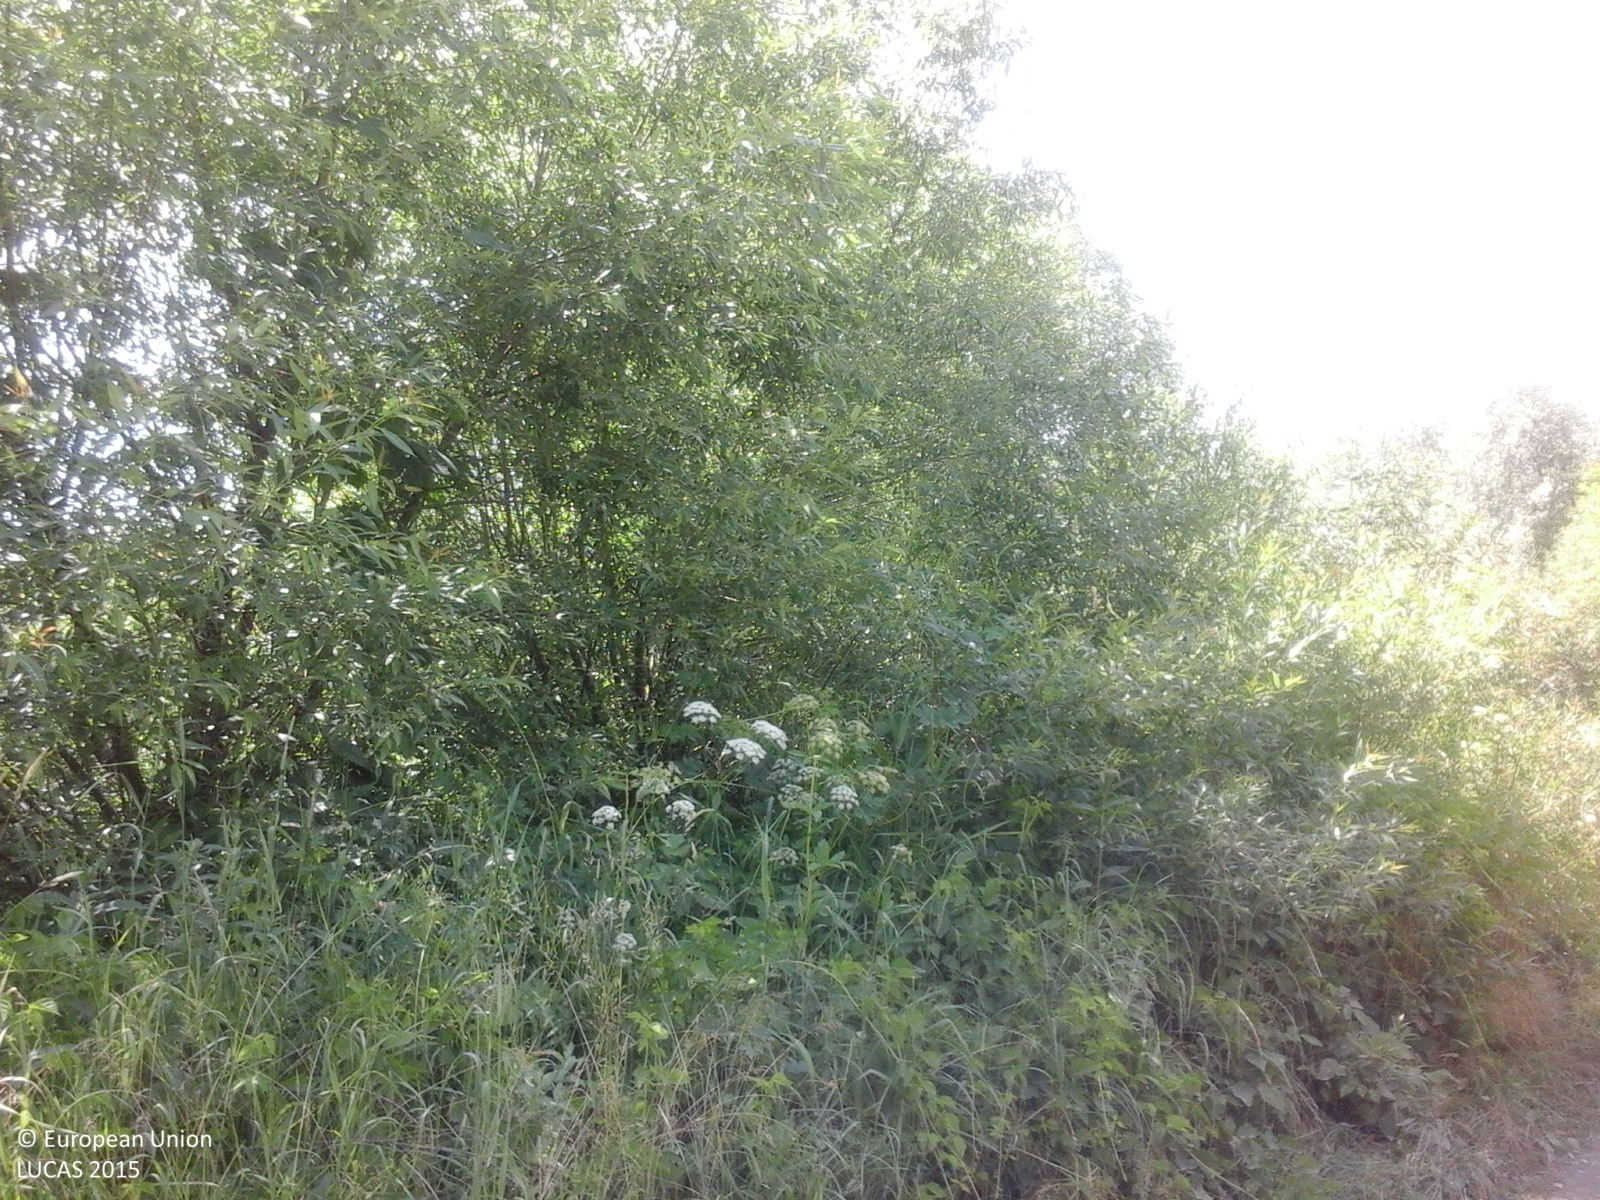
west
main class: Woodland
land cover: Broadleaved woodland
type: thermophilous deciduous forest
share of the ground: > 75 %
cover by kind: broadleaved forest trees 90 %, shrubs 10 %
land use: Semi-natural and natural areas not in use
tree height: > 5 m
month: June
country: RO
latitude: 47.8271
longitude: 25.7948
